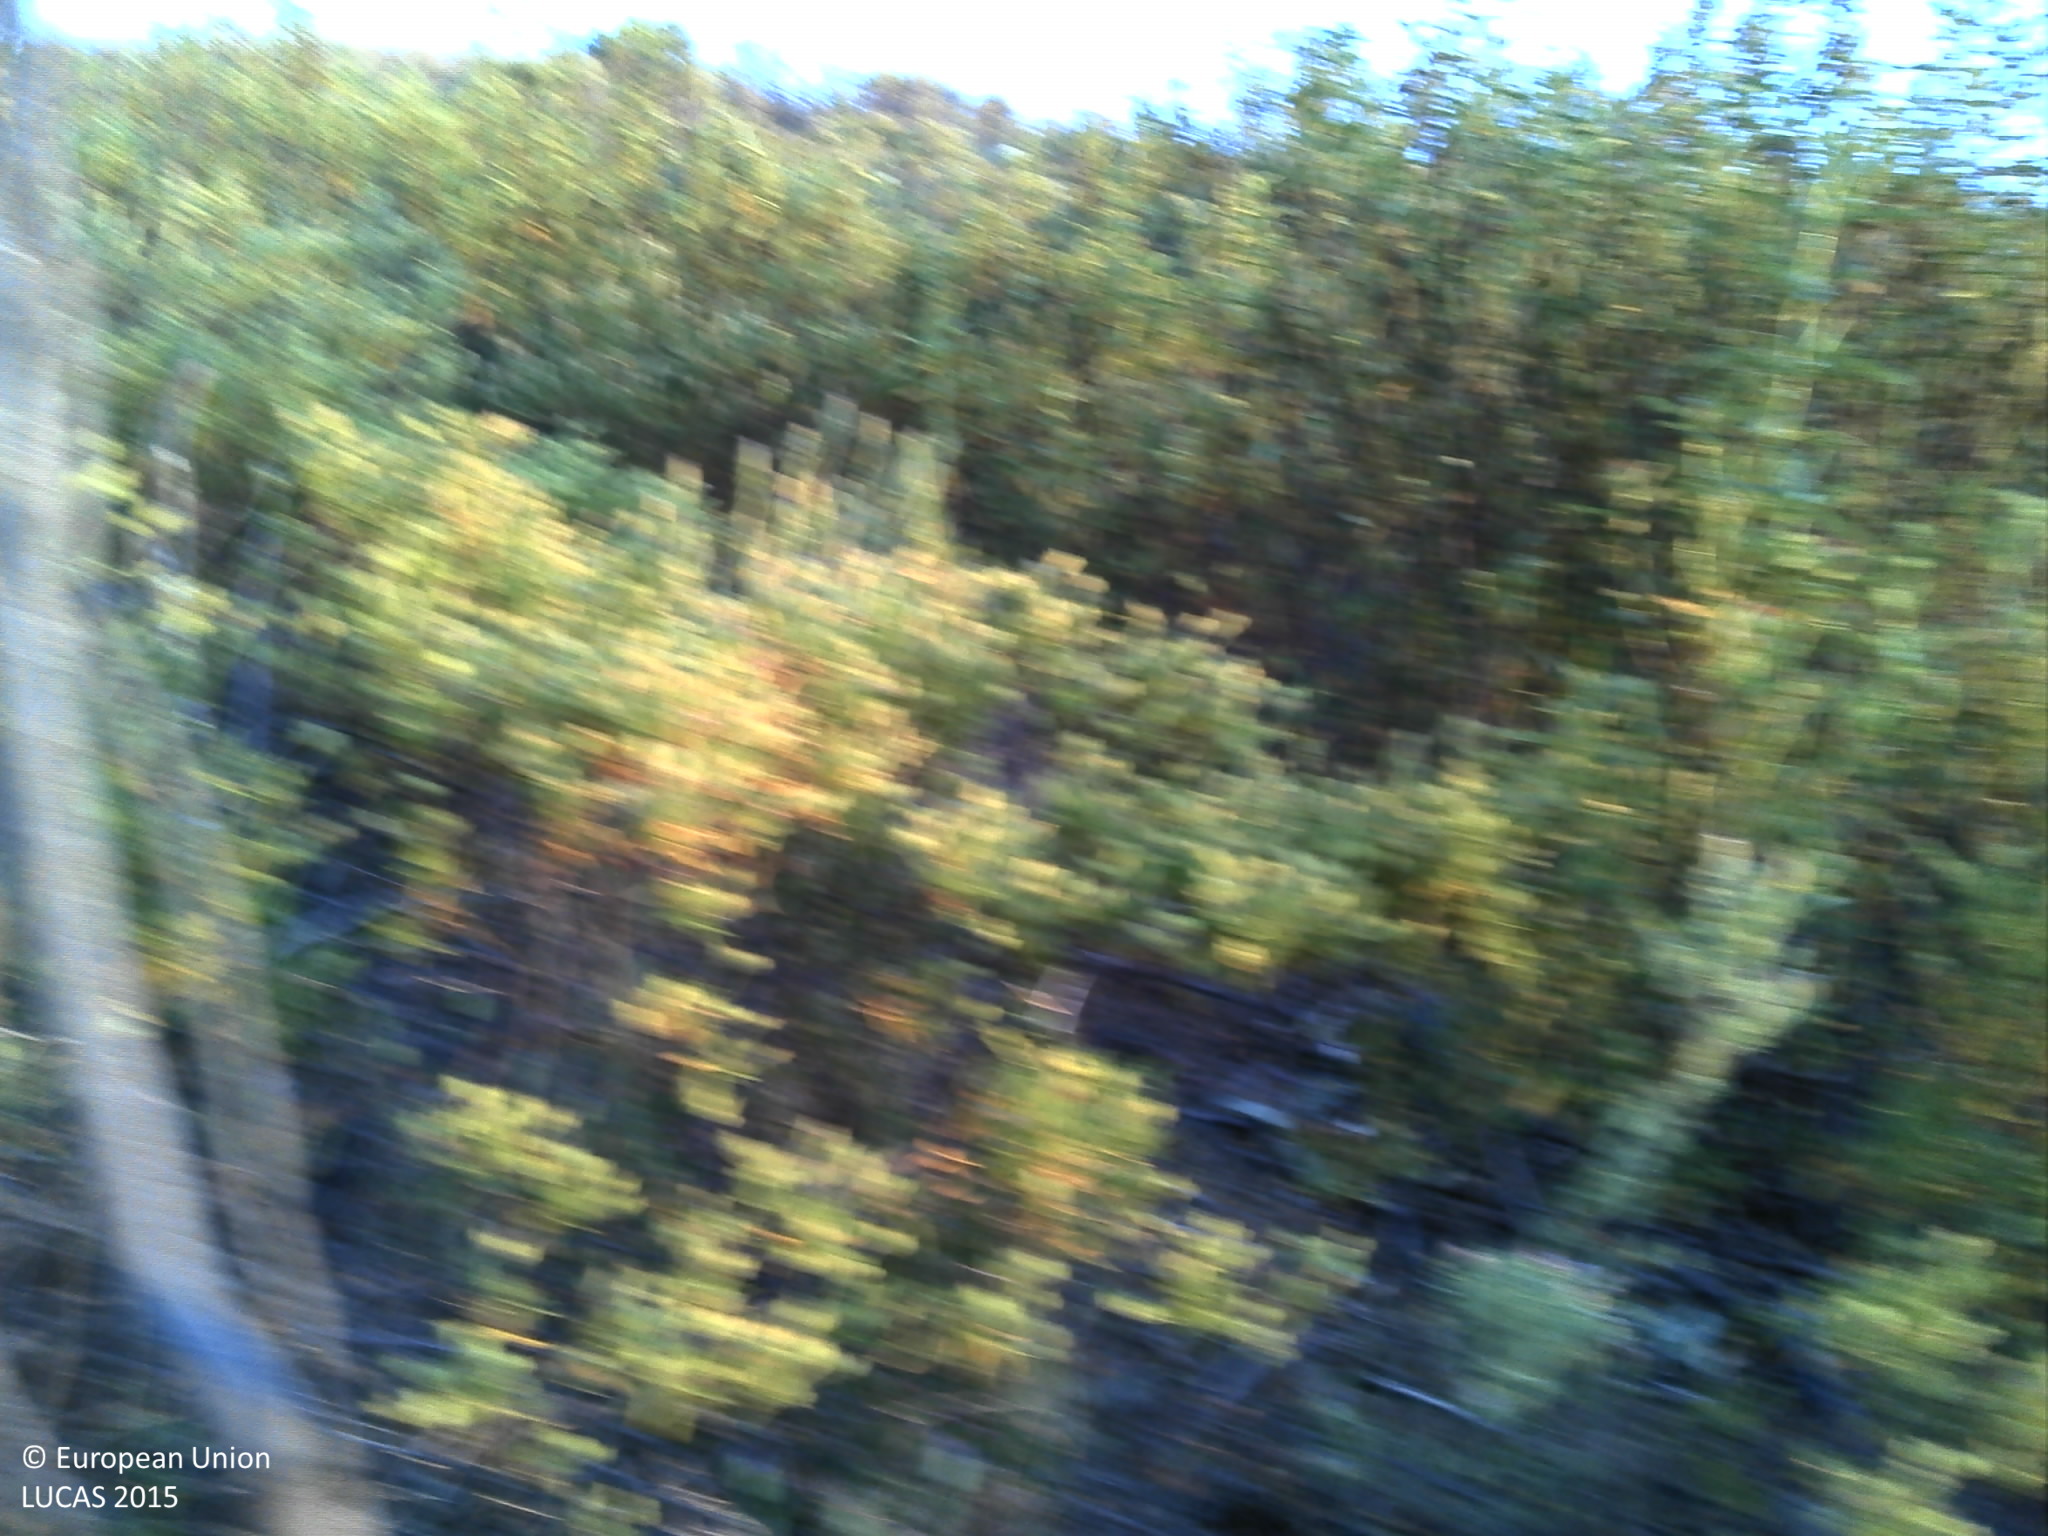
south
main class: Shrubland
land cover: Shrubland without tree cover
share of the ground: > 75 %
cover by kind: shrubs 100 %
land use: Semi-natural and natural areas not in use
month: May
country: PT
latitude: 37.4709
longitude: -7.5470
